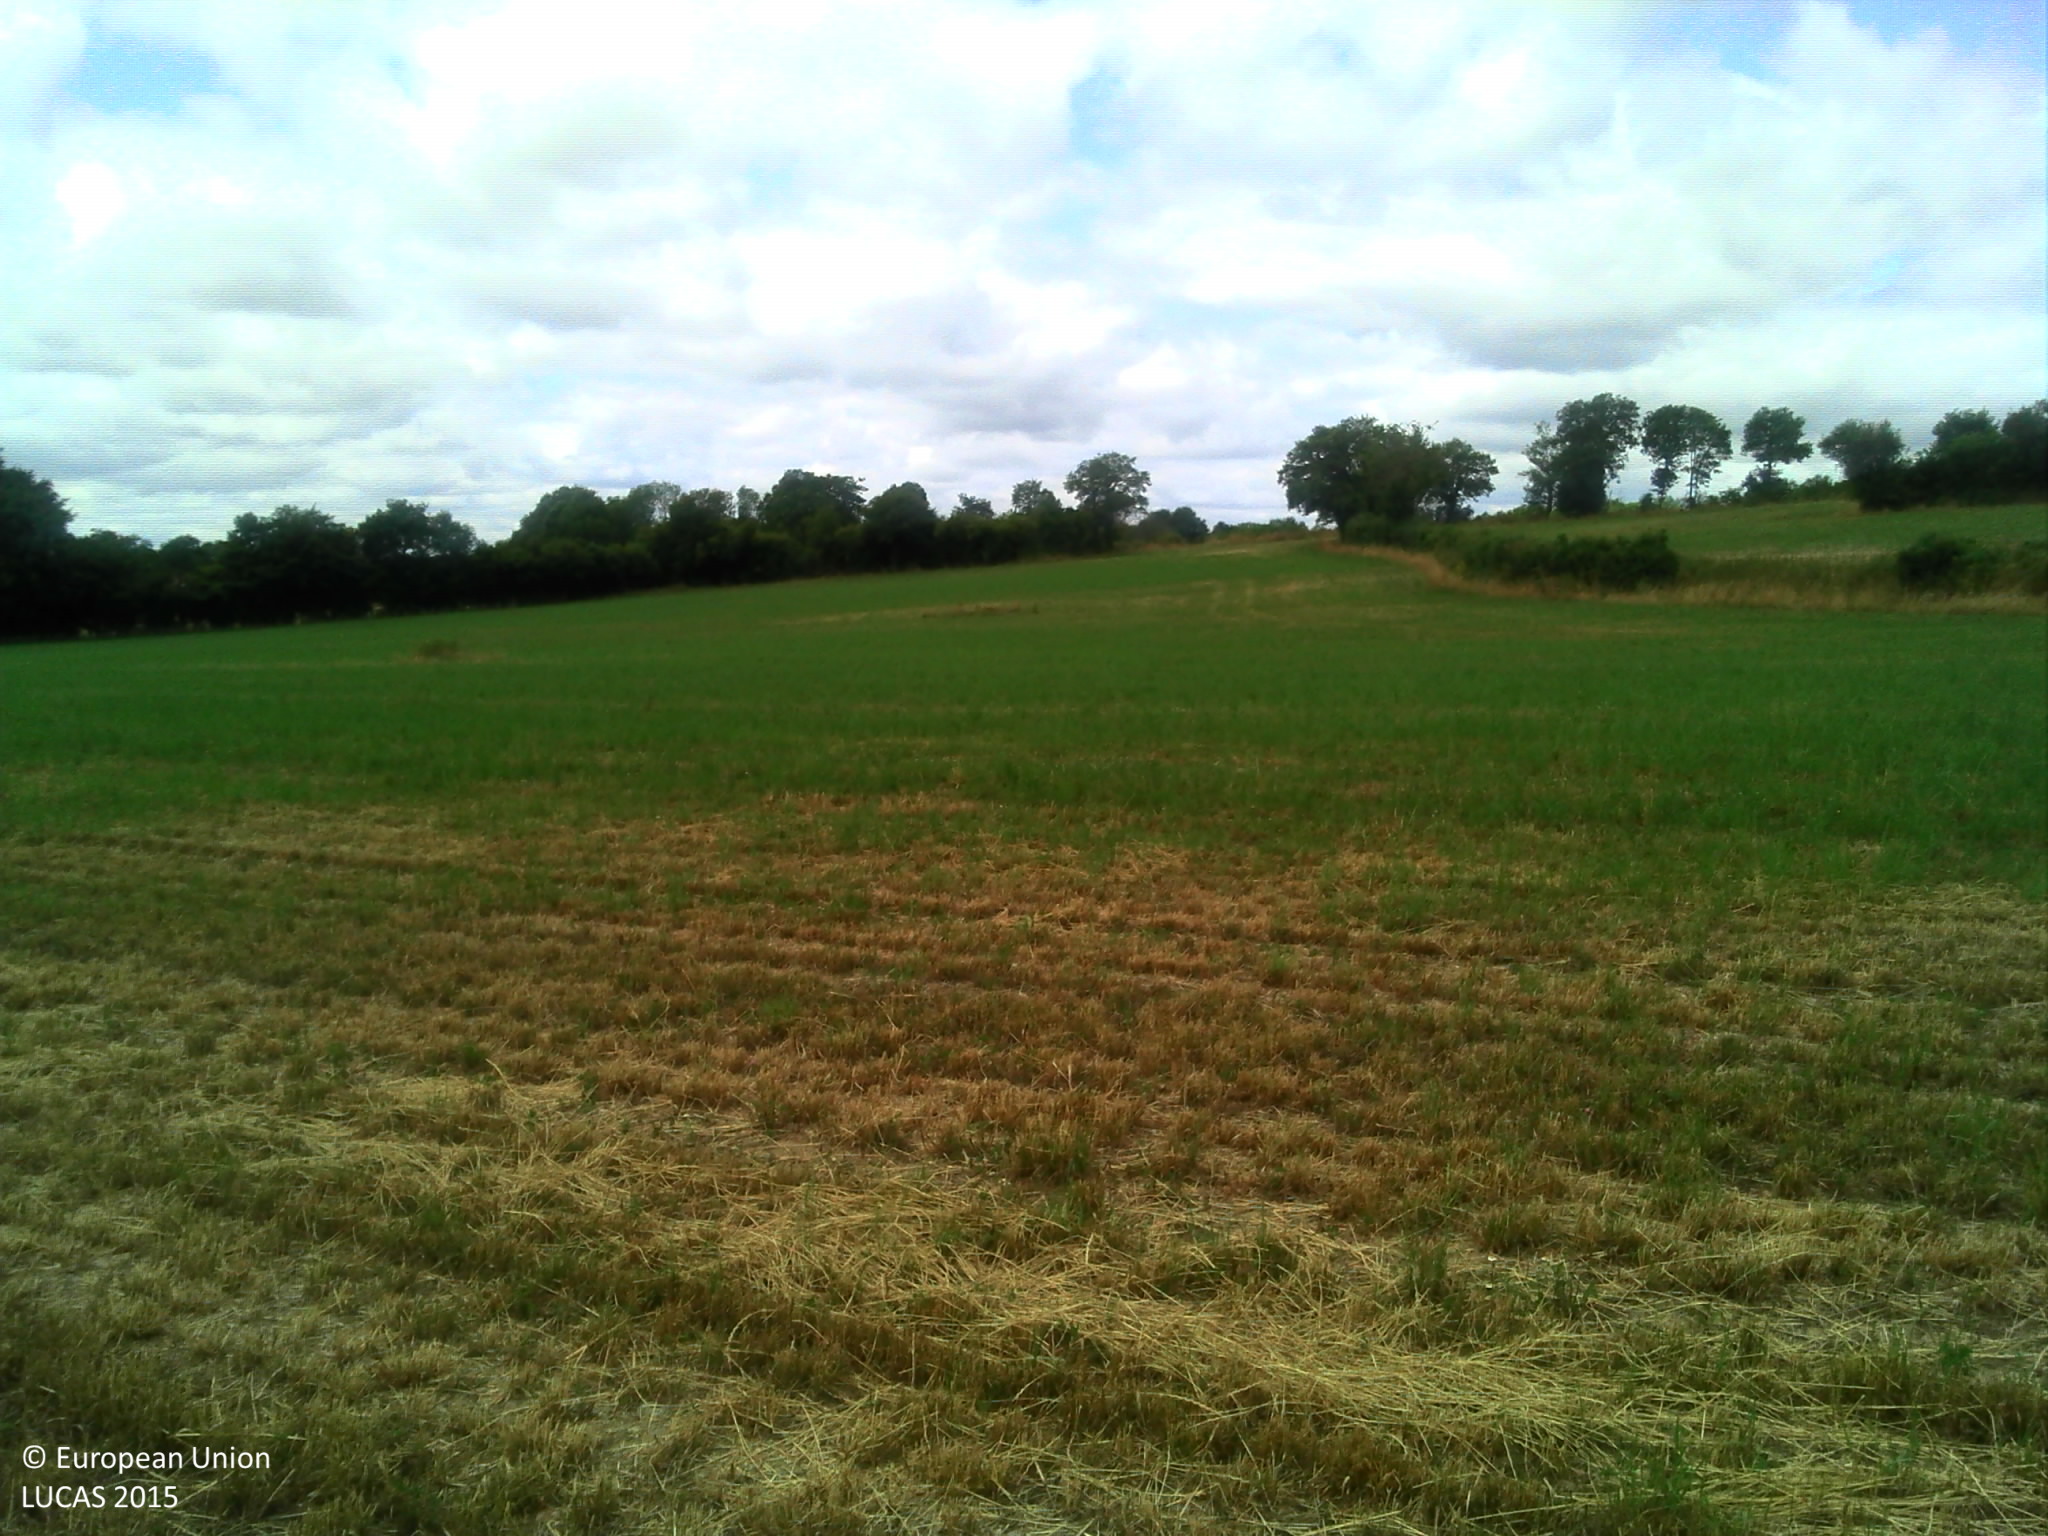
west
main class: Cropland
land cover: Temporary grasslands
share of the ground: > 75 %
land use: Agriculture (excluding fallow land and kitchen gardens)
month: July
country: FR
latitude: 46.3490
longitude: 1.6357
